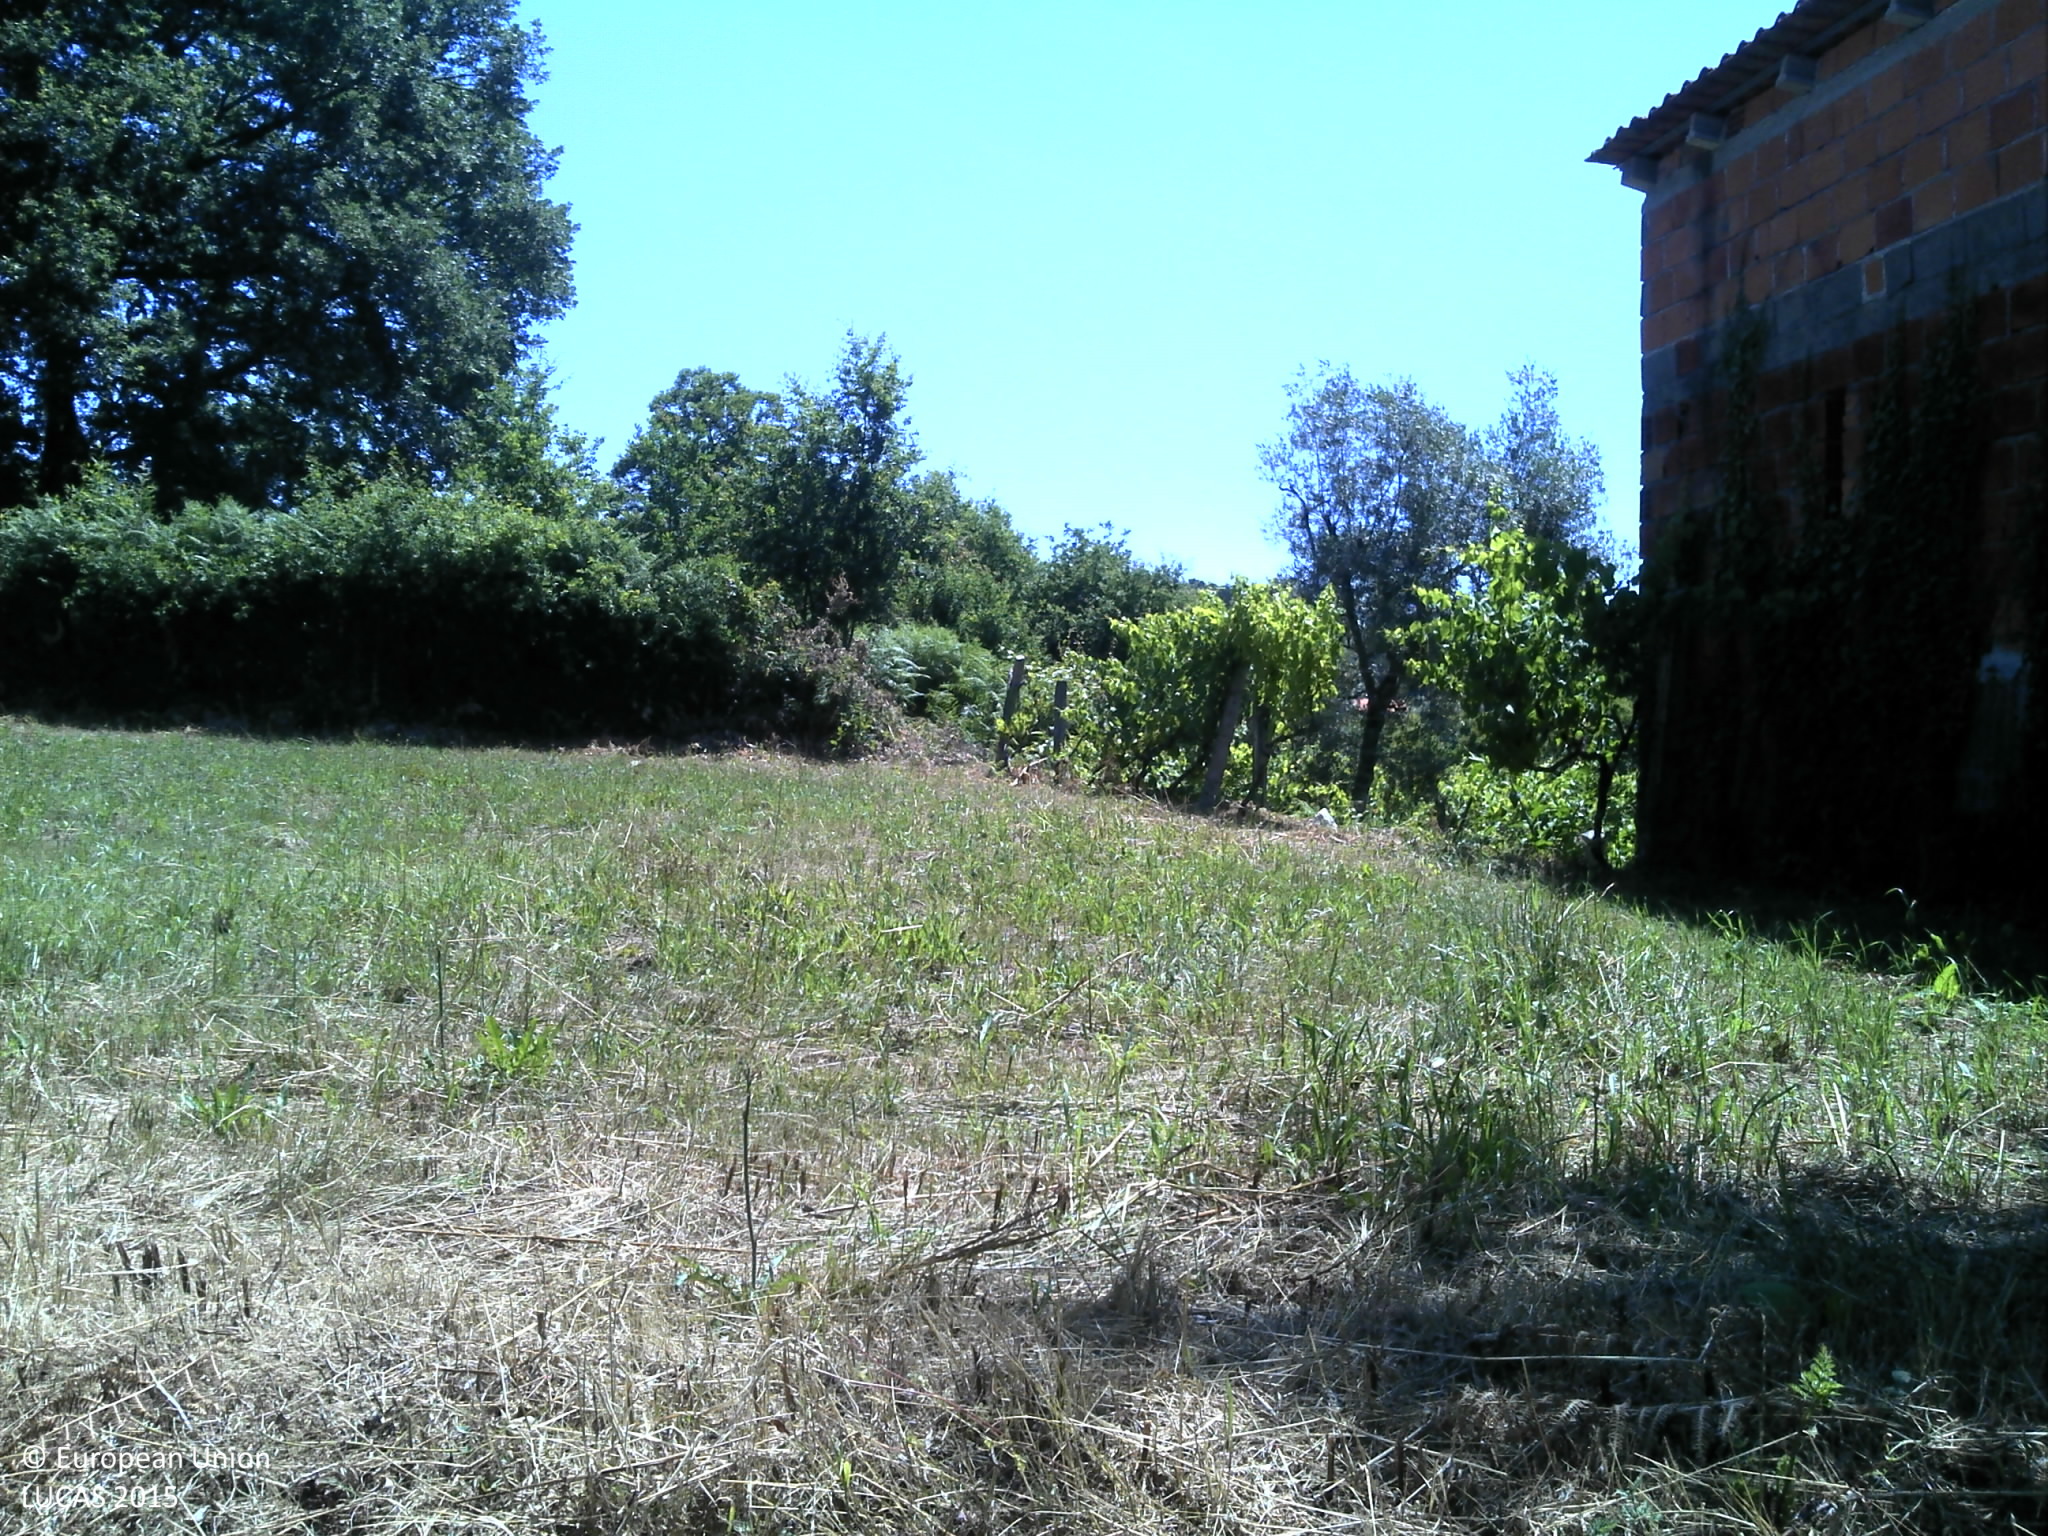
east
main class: Cropland
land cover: Vineyards
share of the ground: < 10 %
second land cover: Grassland without tree/shrub cover
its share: 10 - 25 %
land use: Agriculture (excluding fallow land and kitchen gardens)
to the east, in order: Vineyards; Grassland without tree/shrub cover; Dry stone walls; Tracks; Dry stone walls; Spontaneously vegetated surfaces; Shrubland without tree cover; Broadleaved woodland; Dry stone walls; Vineyards; Other root crops; Grassland without tree/shrub cover; Dry stone walls; Other root crops; Vineyards; Maize; Dry stone walls; Maize; Electric lines; Maize; Grass margins; Tracks; Dry stone walls; Vineyards; Spontaneously vegetated surfaces; Grassland without tree/shrub cover; Vineyards; Maize
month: June
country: PT
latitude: 40.7794
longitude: -8.0337
